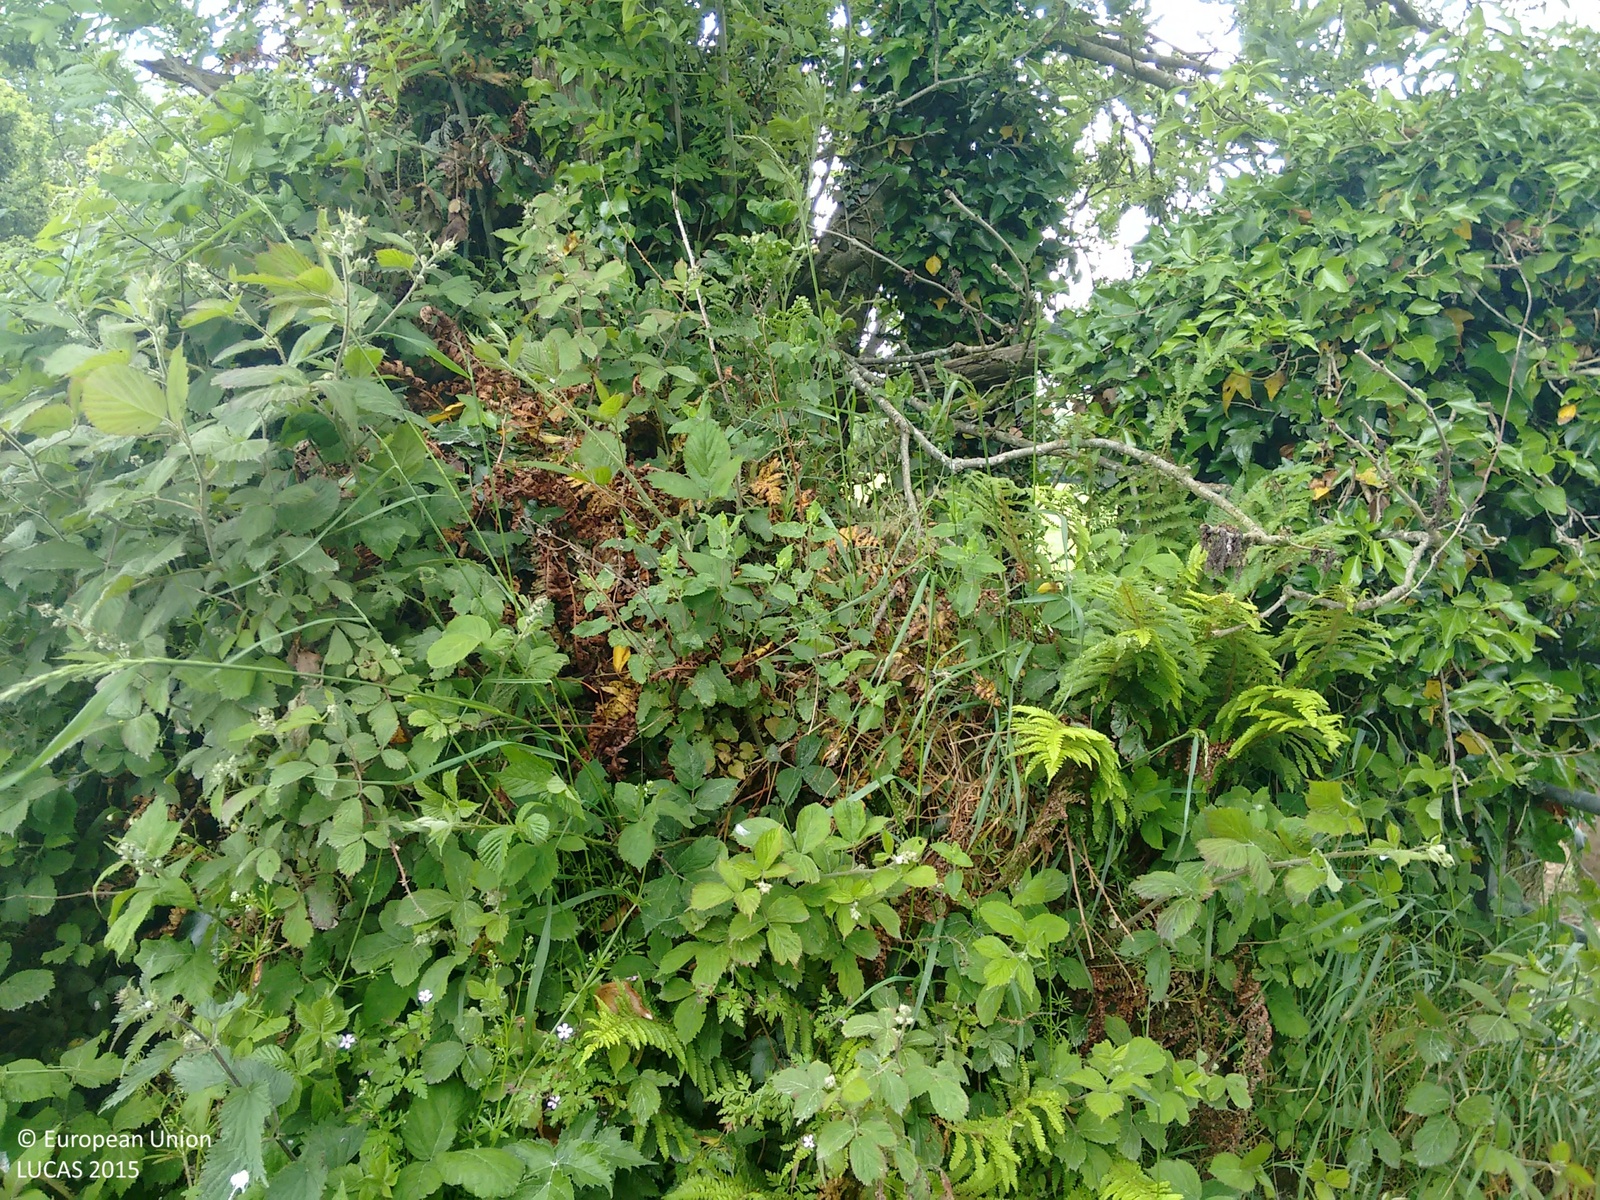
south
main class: Grassland
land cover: Grassland without tree/shrub cover
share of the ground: > 75 %
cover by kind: herbaceous plants 100 %
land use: Agriculture (excluding fallow land and kitchen gardens)
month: June
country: IE
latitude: 52.0004
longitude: -8.1107
